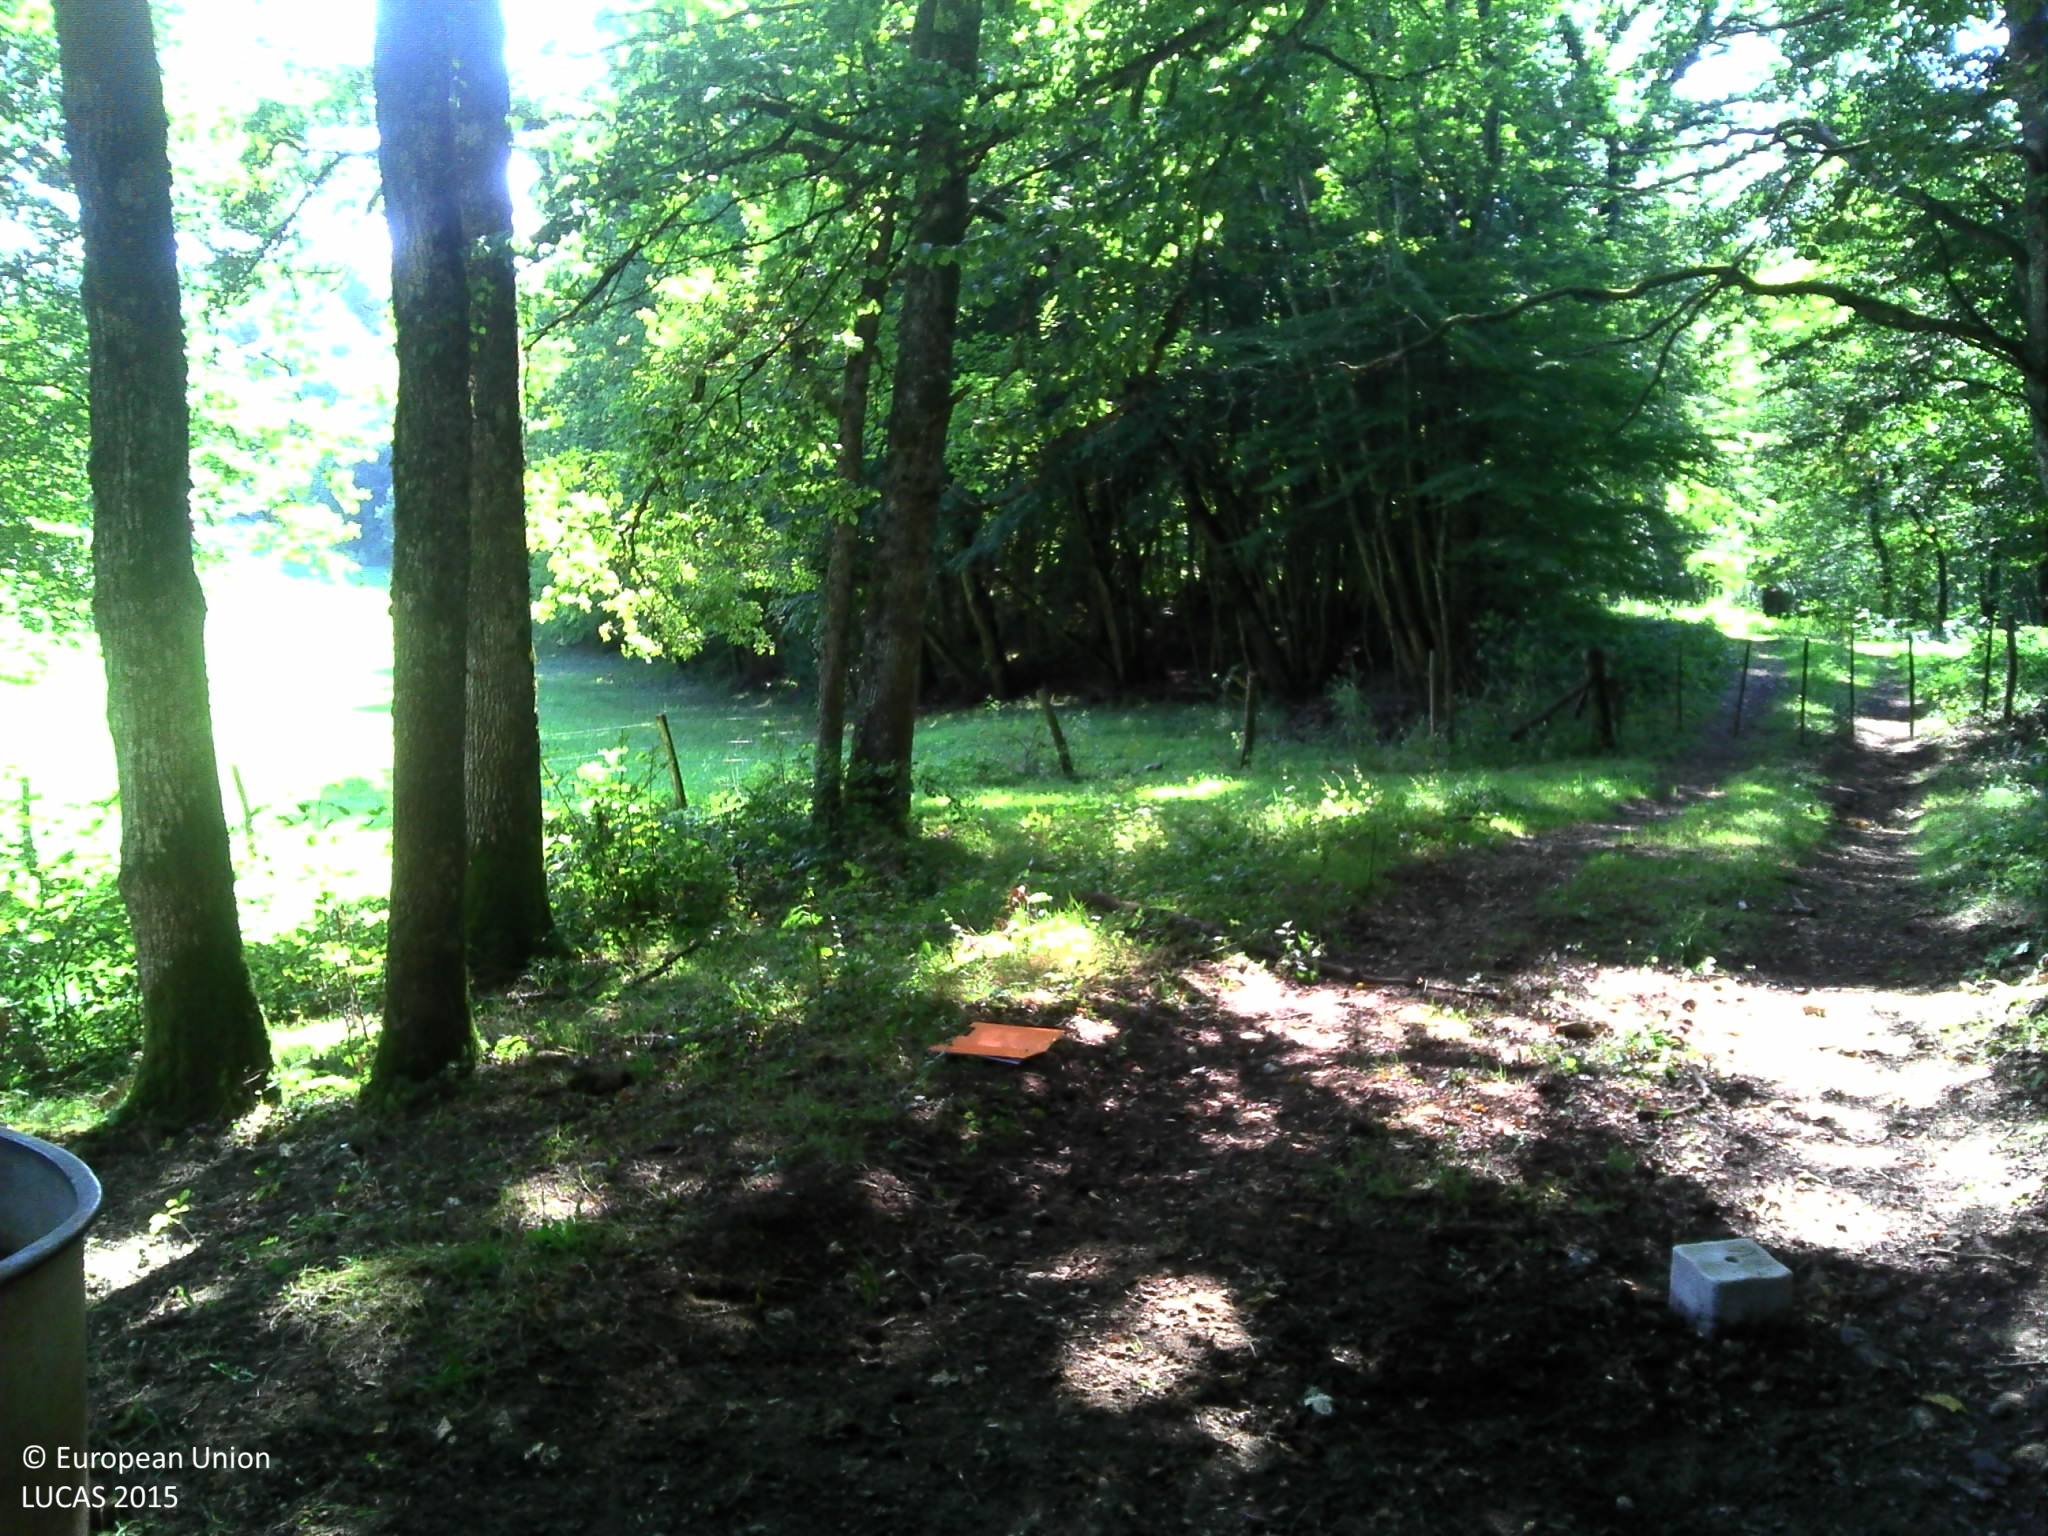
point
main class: Woodland
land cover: Broadleaved woodland
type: beech forest
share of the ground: > 75 %
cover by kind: broadleaved forest trees 90 %, unconsolidated bare surface 10 %
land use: Forestry
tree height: > 5 m
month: September
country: FR
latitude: 47.2431
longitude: 6.3160
